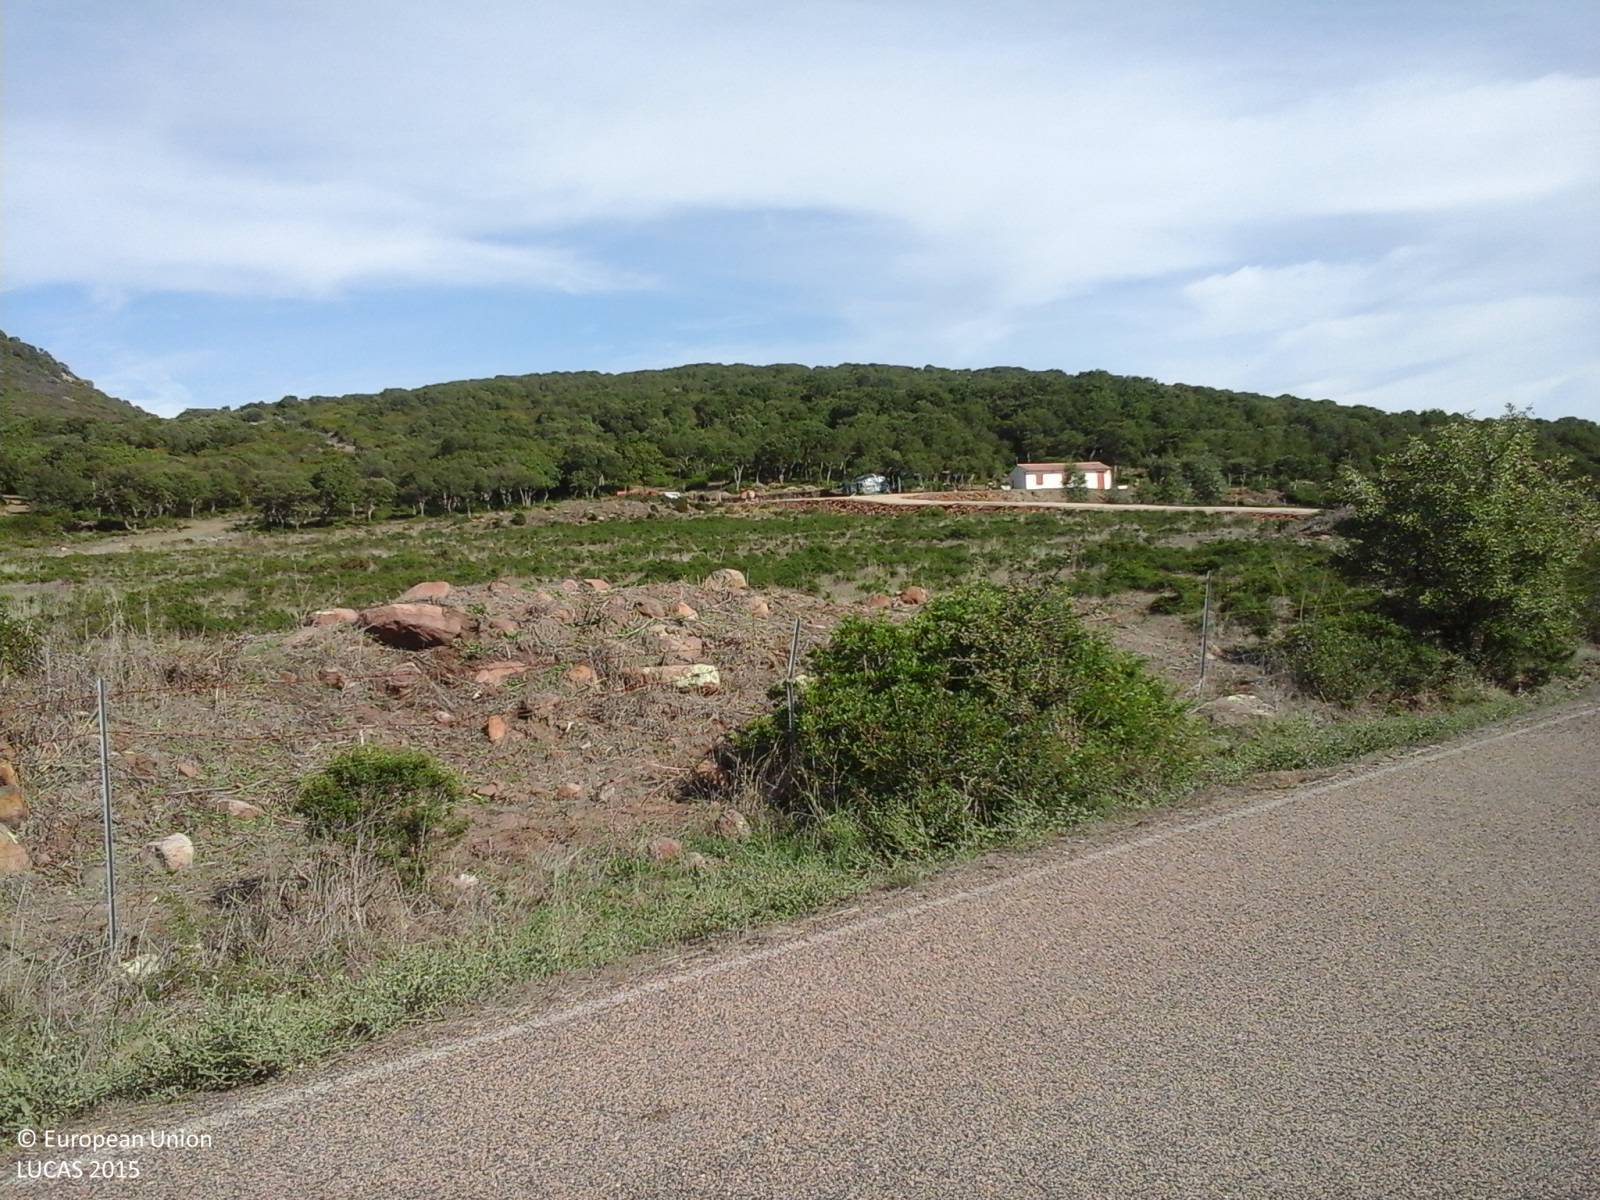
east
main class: Grassland
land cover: Grassland without tree/shrub cover
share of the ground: > 75 %
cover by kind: herbaceous plants 100 %
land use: Agriculture (excluding fallow land and kitchen gardens)
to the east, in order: Grassland without tree/shrub cover
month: October
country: IT
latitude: 40.4193
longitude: 8.5342
